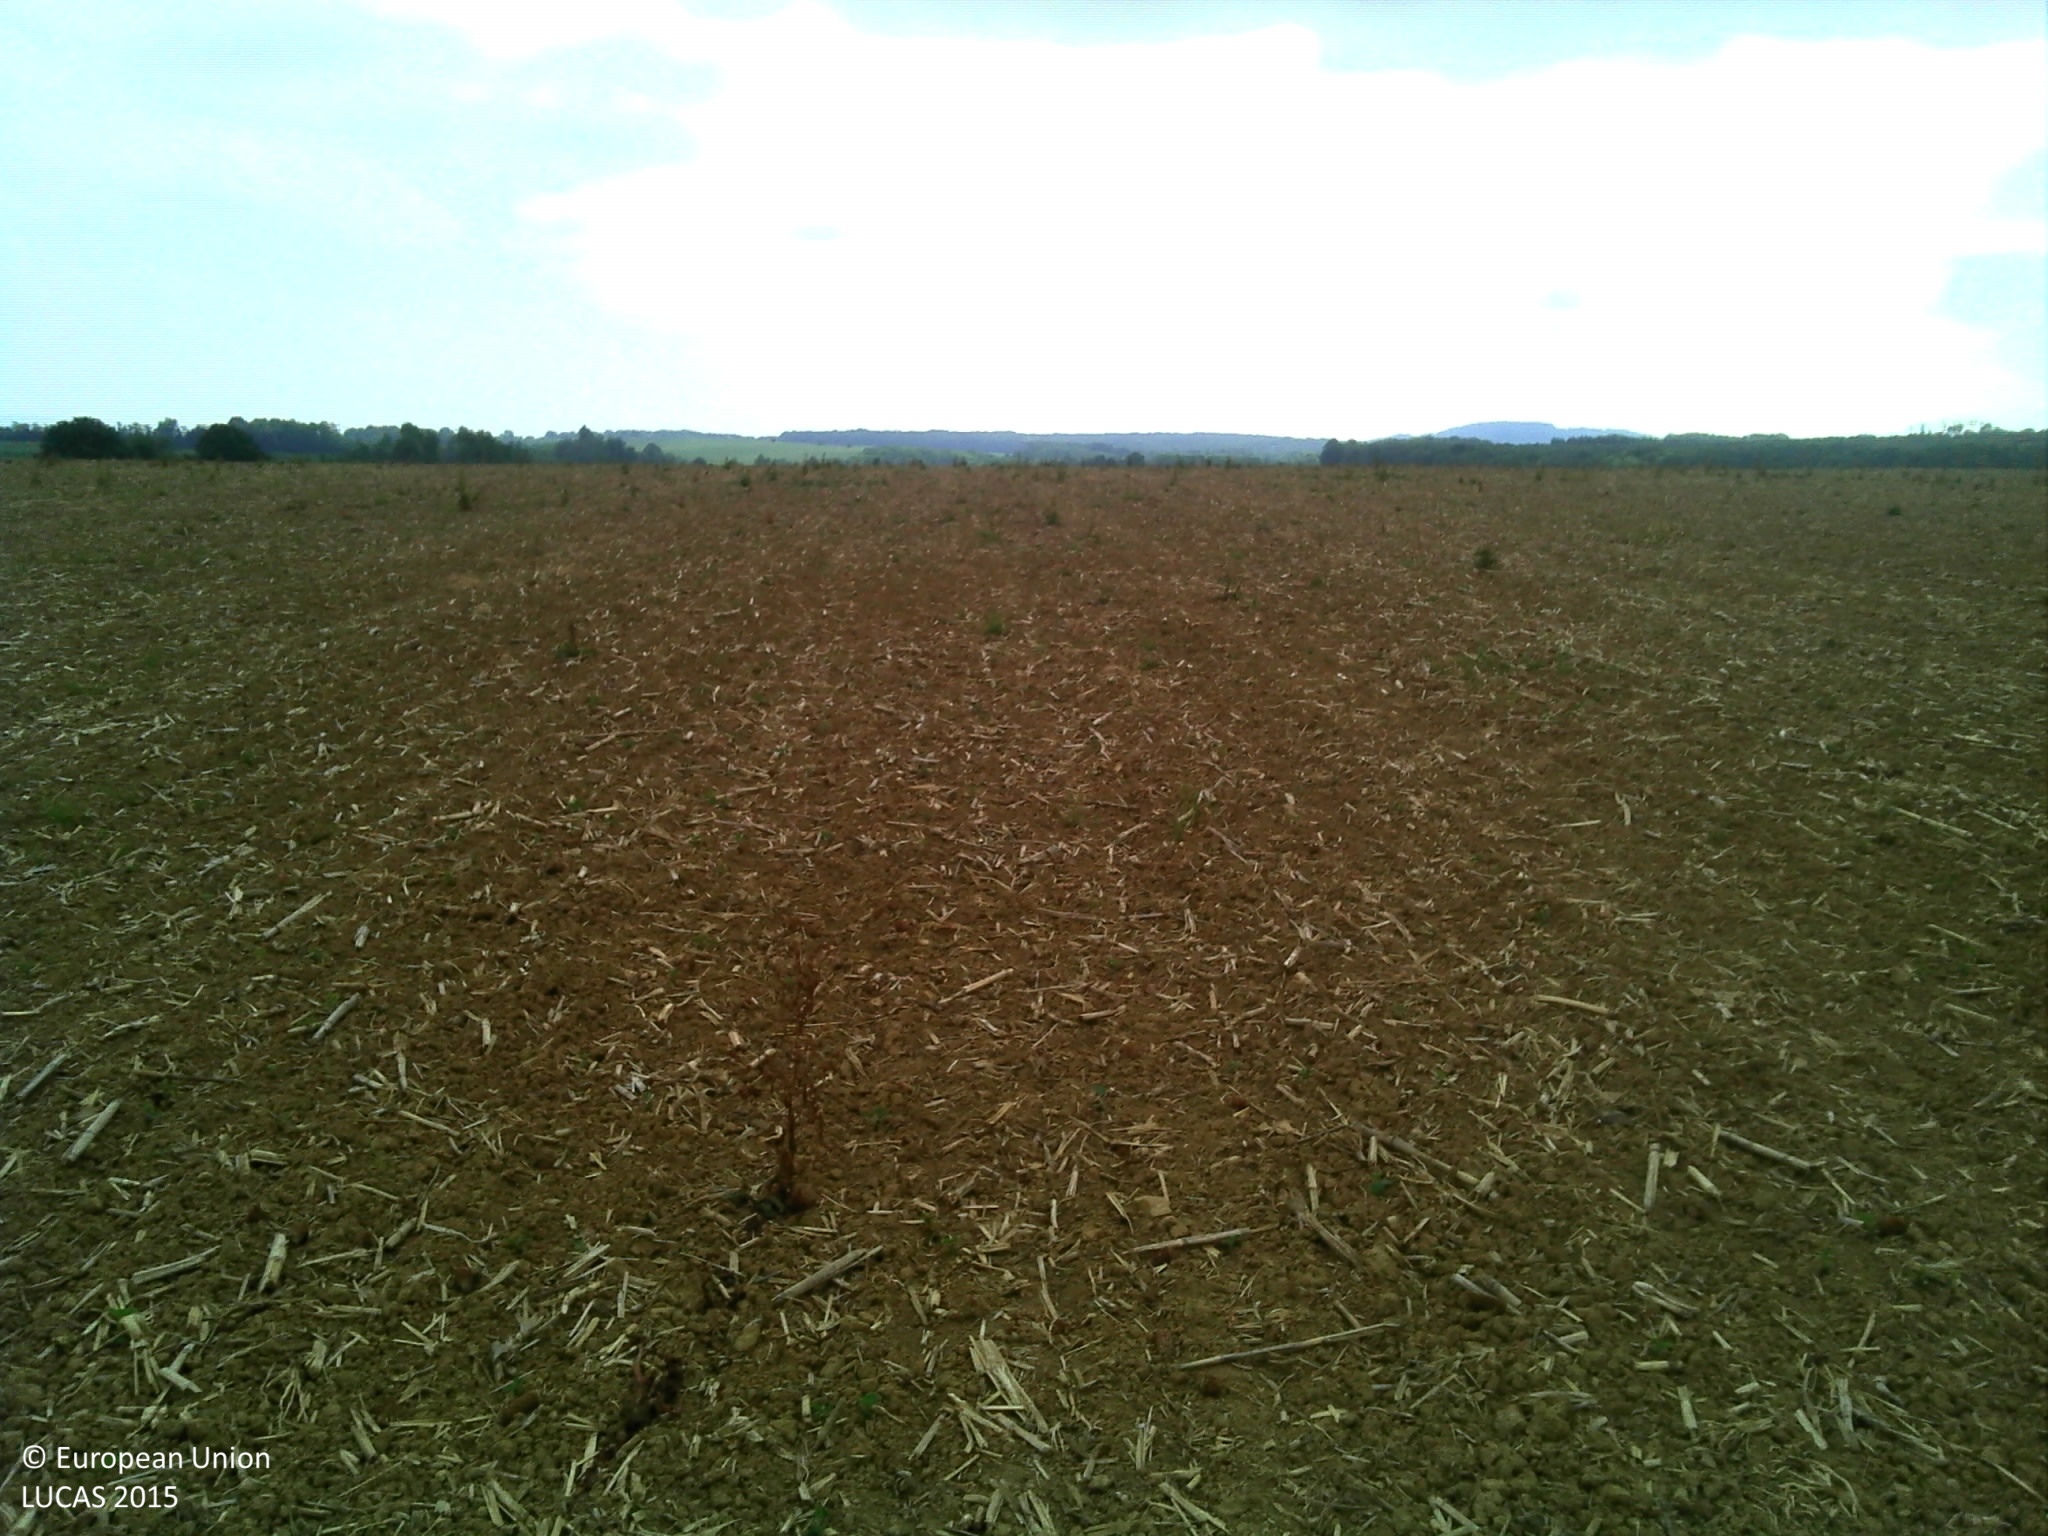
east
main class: Cropland
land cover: Soya
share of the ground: < 10 %
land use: Agriculture (excluding fallow land and kitchen gardens)
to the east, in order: Soya
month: June
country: FR
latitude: 47.7598
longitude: 6.1455
